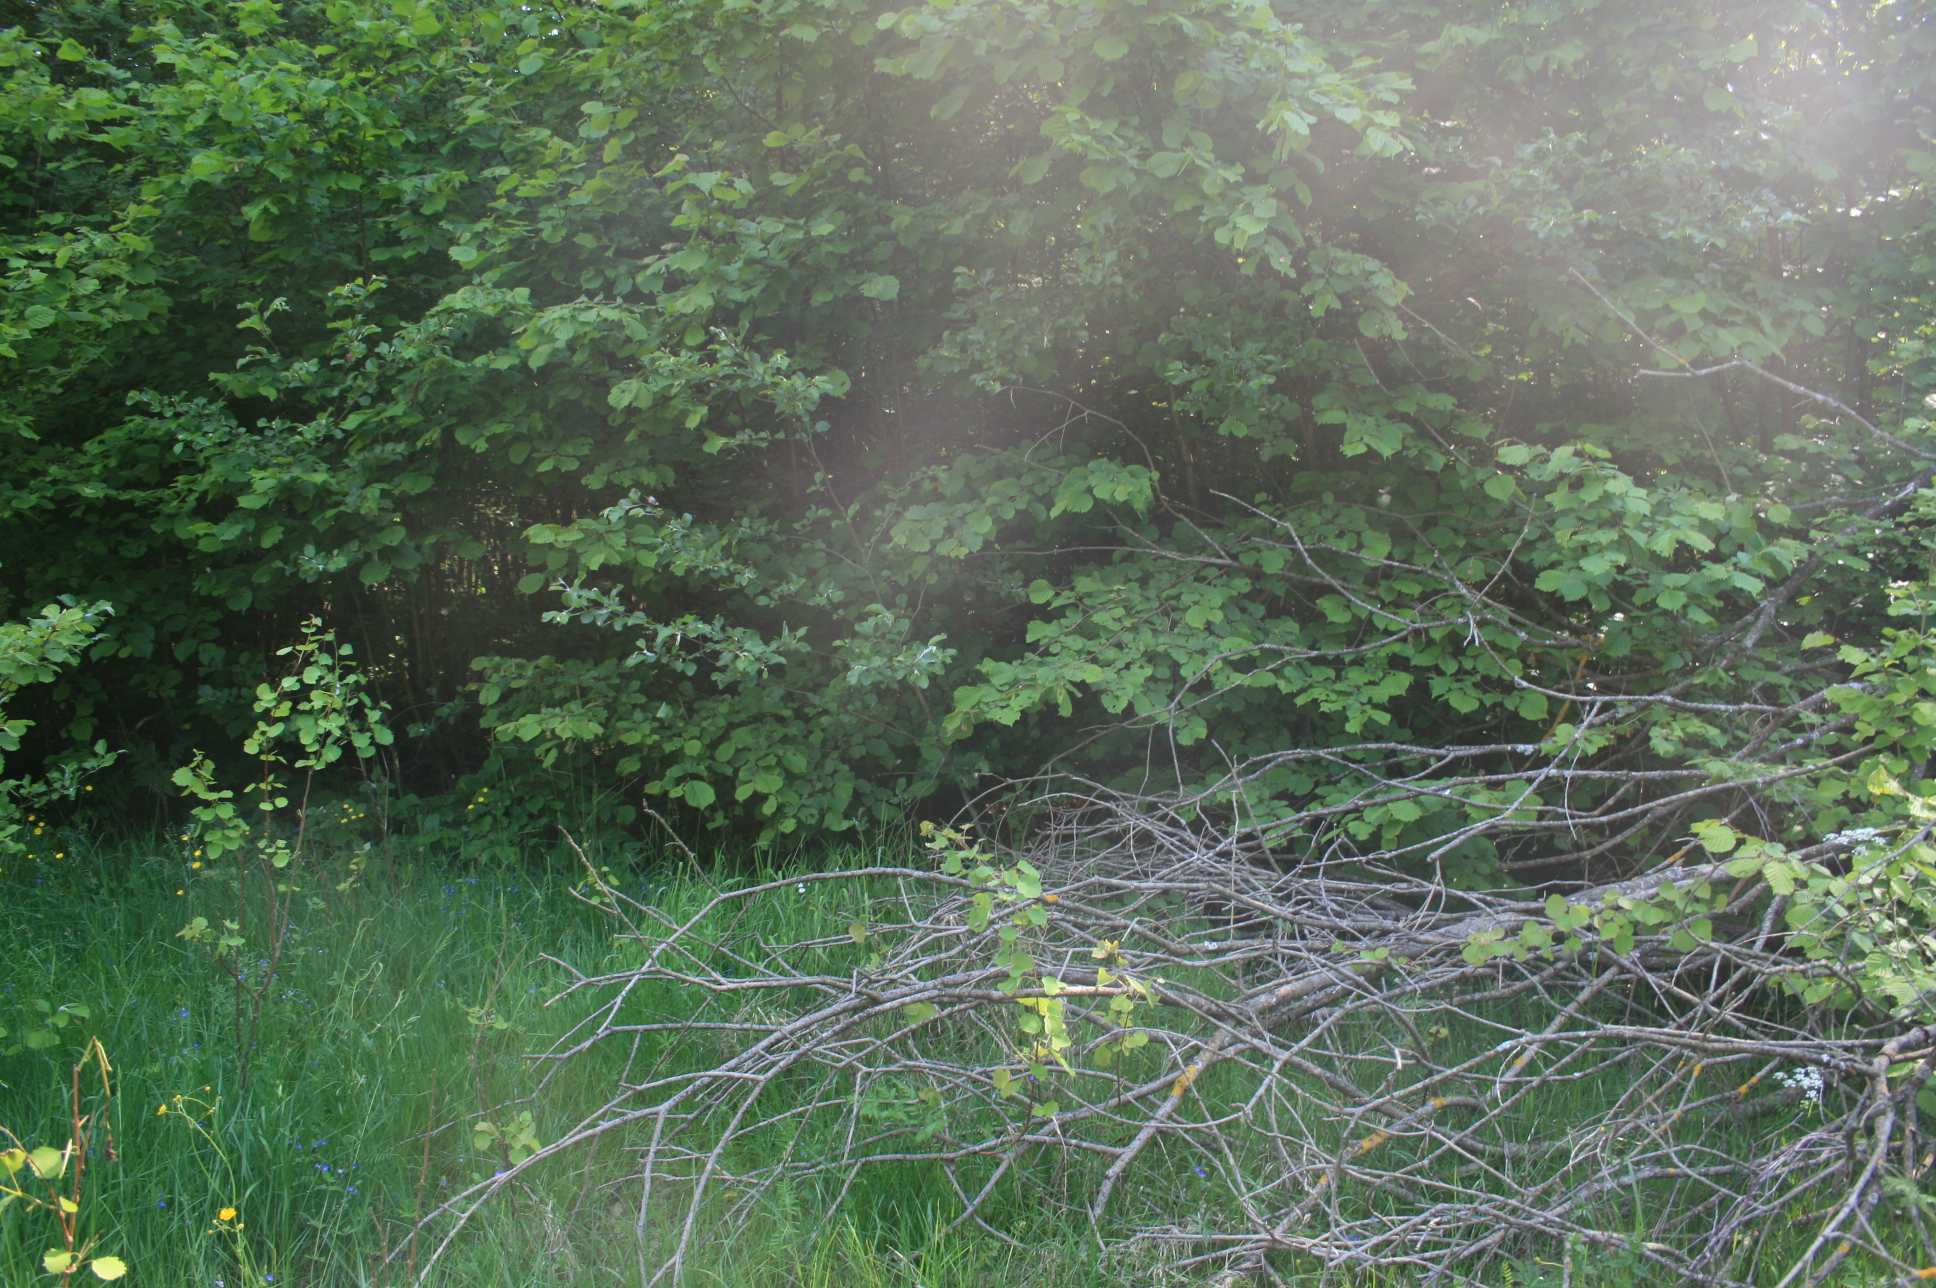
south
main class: Grassland
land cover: Grassland without tree/shrub cover
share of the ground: > 75 %
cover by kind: herbaceous plants 100 %
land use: Agriculture (excluding fallow land and kitchen gardens)
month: June
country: LT
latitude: 55.5885
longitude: 22.1613
